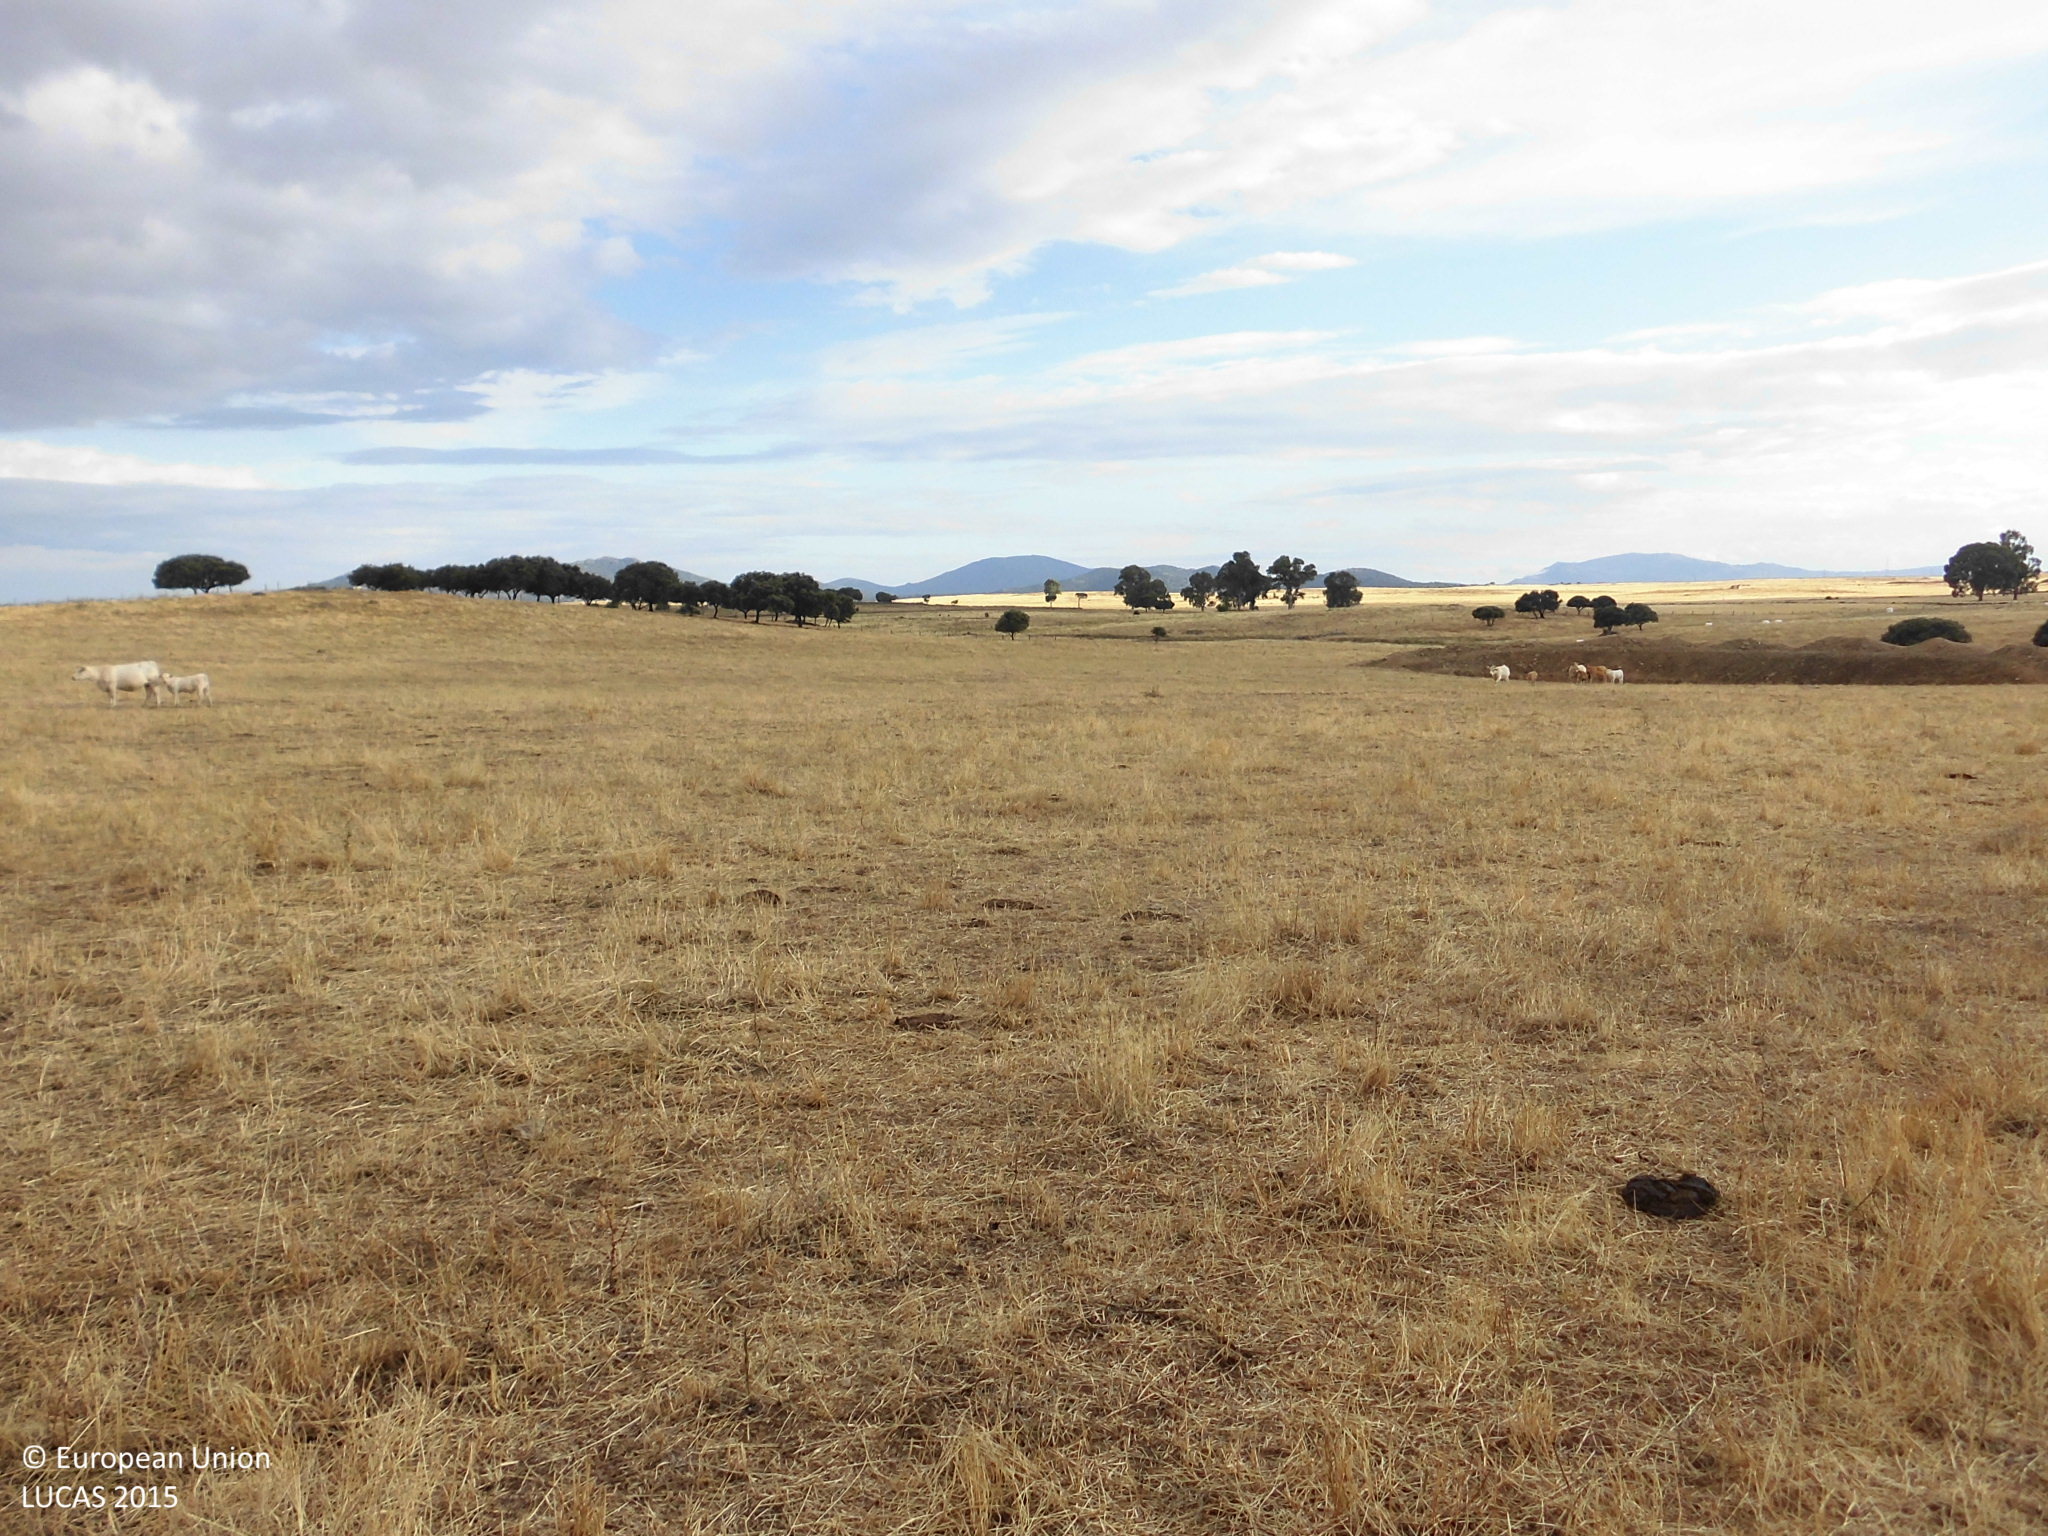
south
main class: Grassland
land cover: Grassland with sparse tree/shrub cover
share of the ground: > 75 %
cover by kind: herbaceous plants 95 %, broadleaved forest trees 5 %
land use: Agriculture (excluding fallow land and kitchen gardens)
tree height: > 5 m
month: June
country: ES
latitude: 39.3372
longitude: -5.9639
